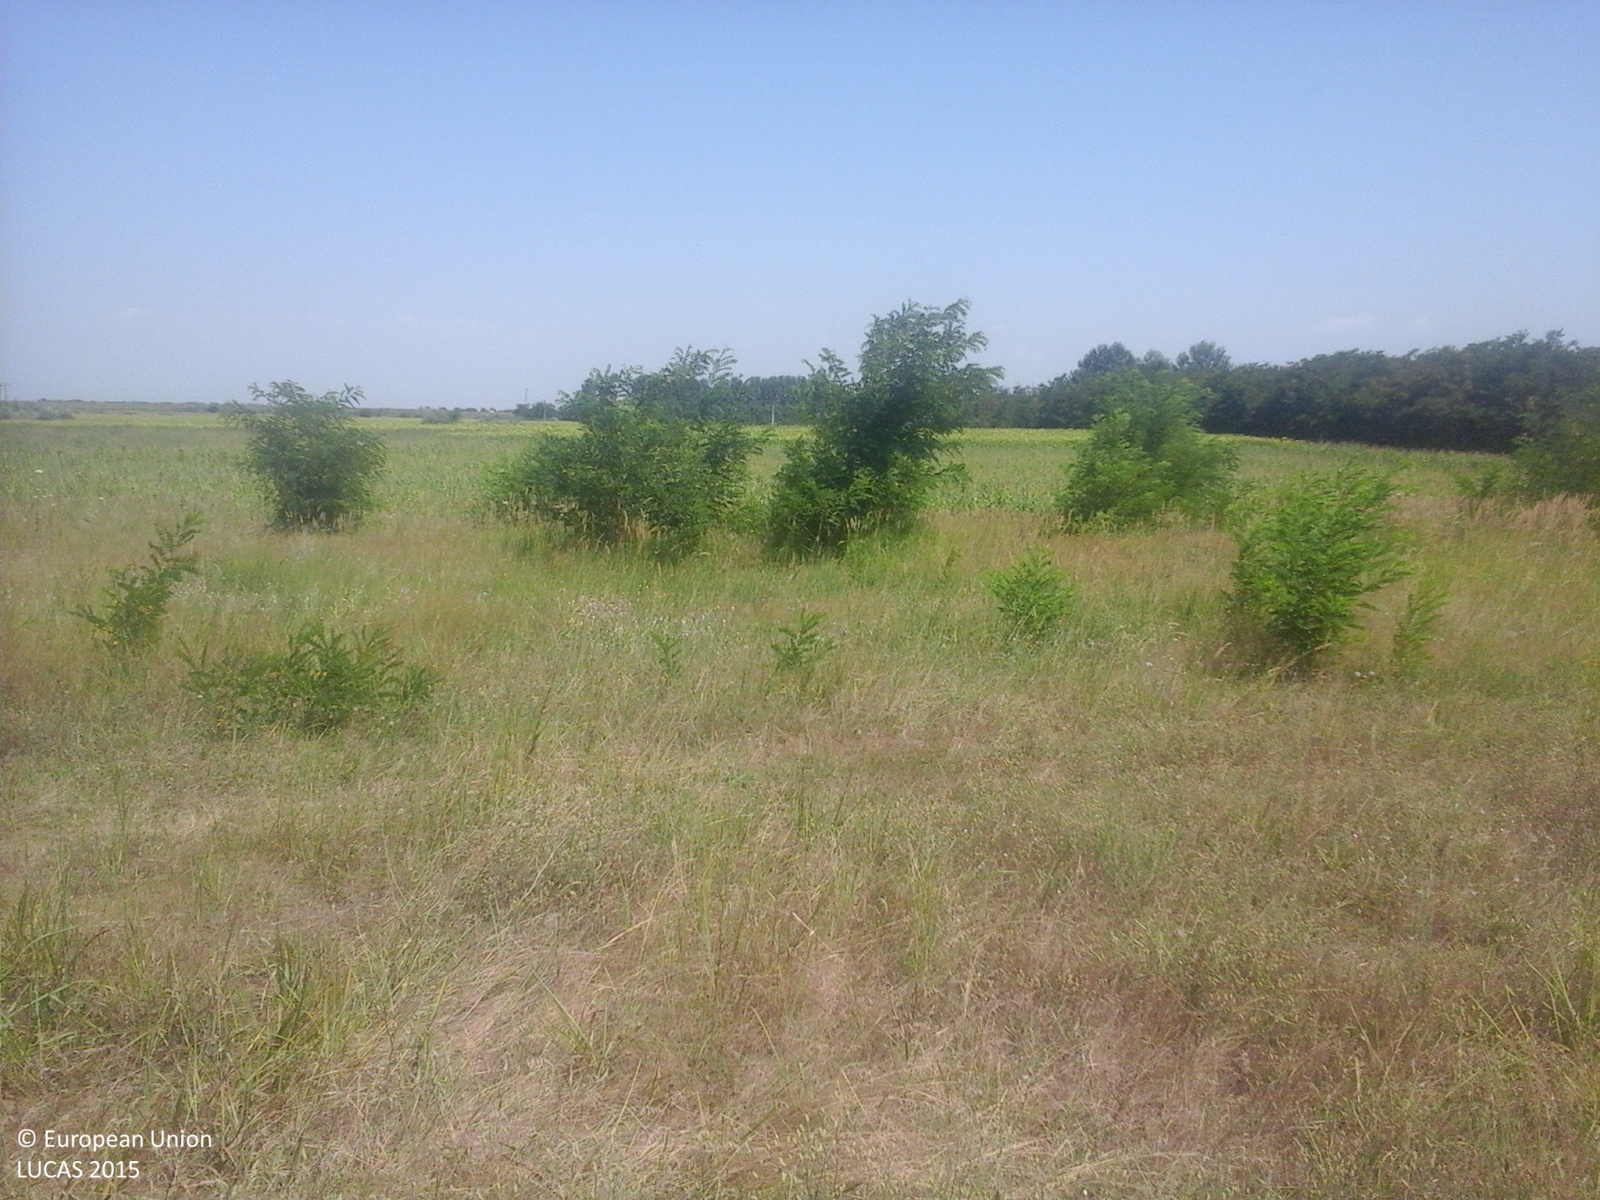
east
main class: Grassland
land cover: Grassland with sparse tree/shrub cover
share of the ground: > 75 %
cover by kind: herbaceous plants 85 %, shrubs 10 %, broadleaved forest trees 5 %
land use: Agriculture (excluding fallow land and kitchen gardens)
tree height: < 5 m
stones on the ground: < 10 %
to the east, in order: Grassland with sparse tree/shrub cover; Sunflower; Spontaneously vegetated surfaces
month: July
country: RO
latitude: 44.8589
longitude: 27.7052
